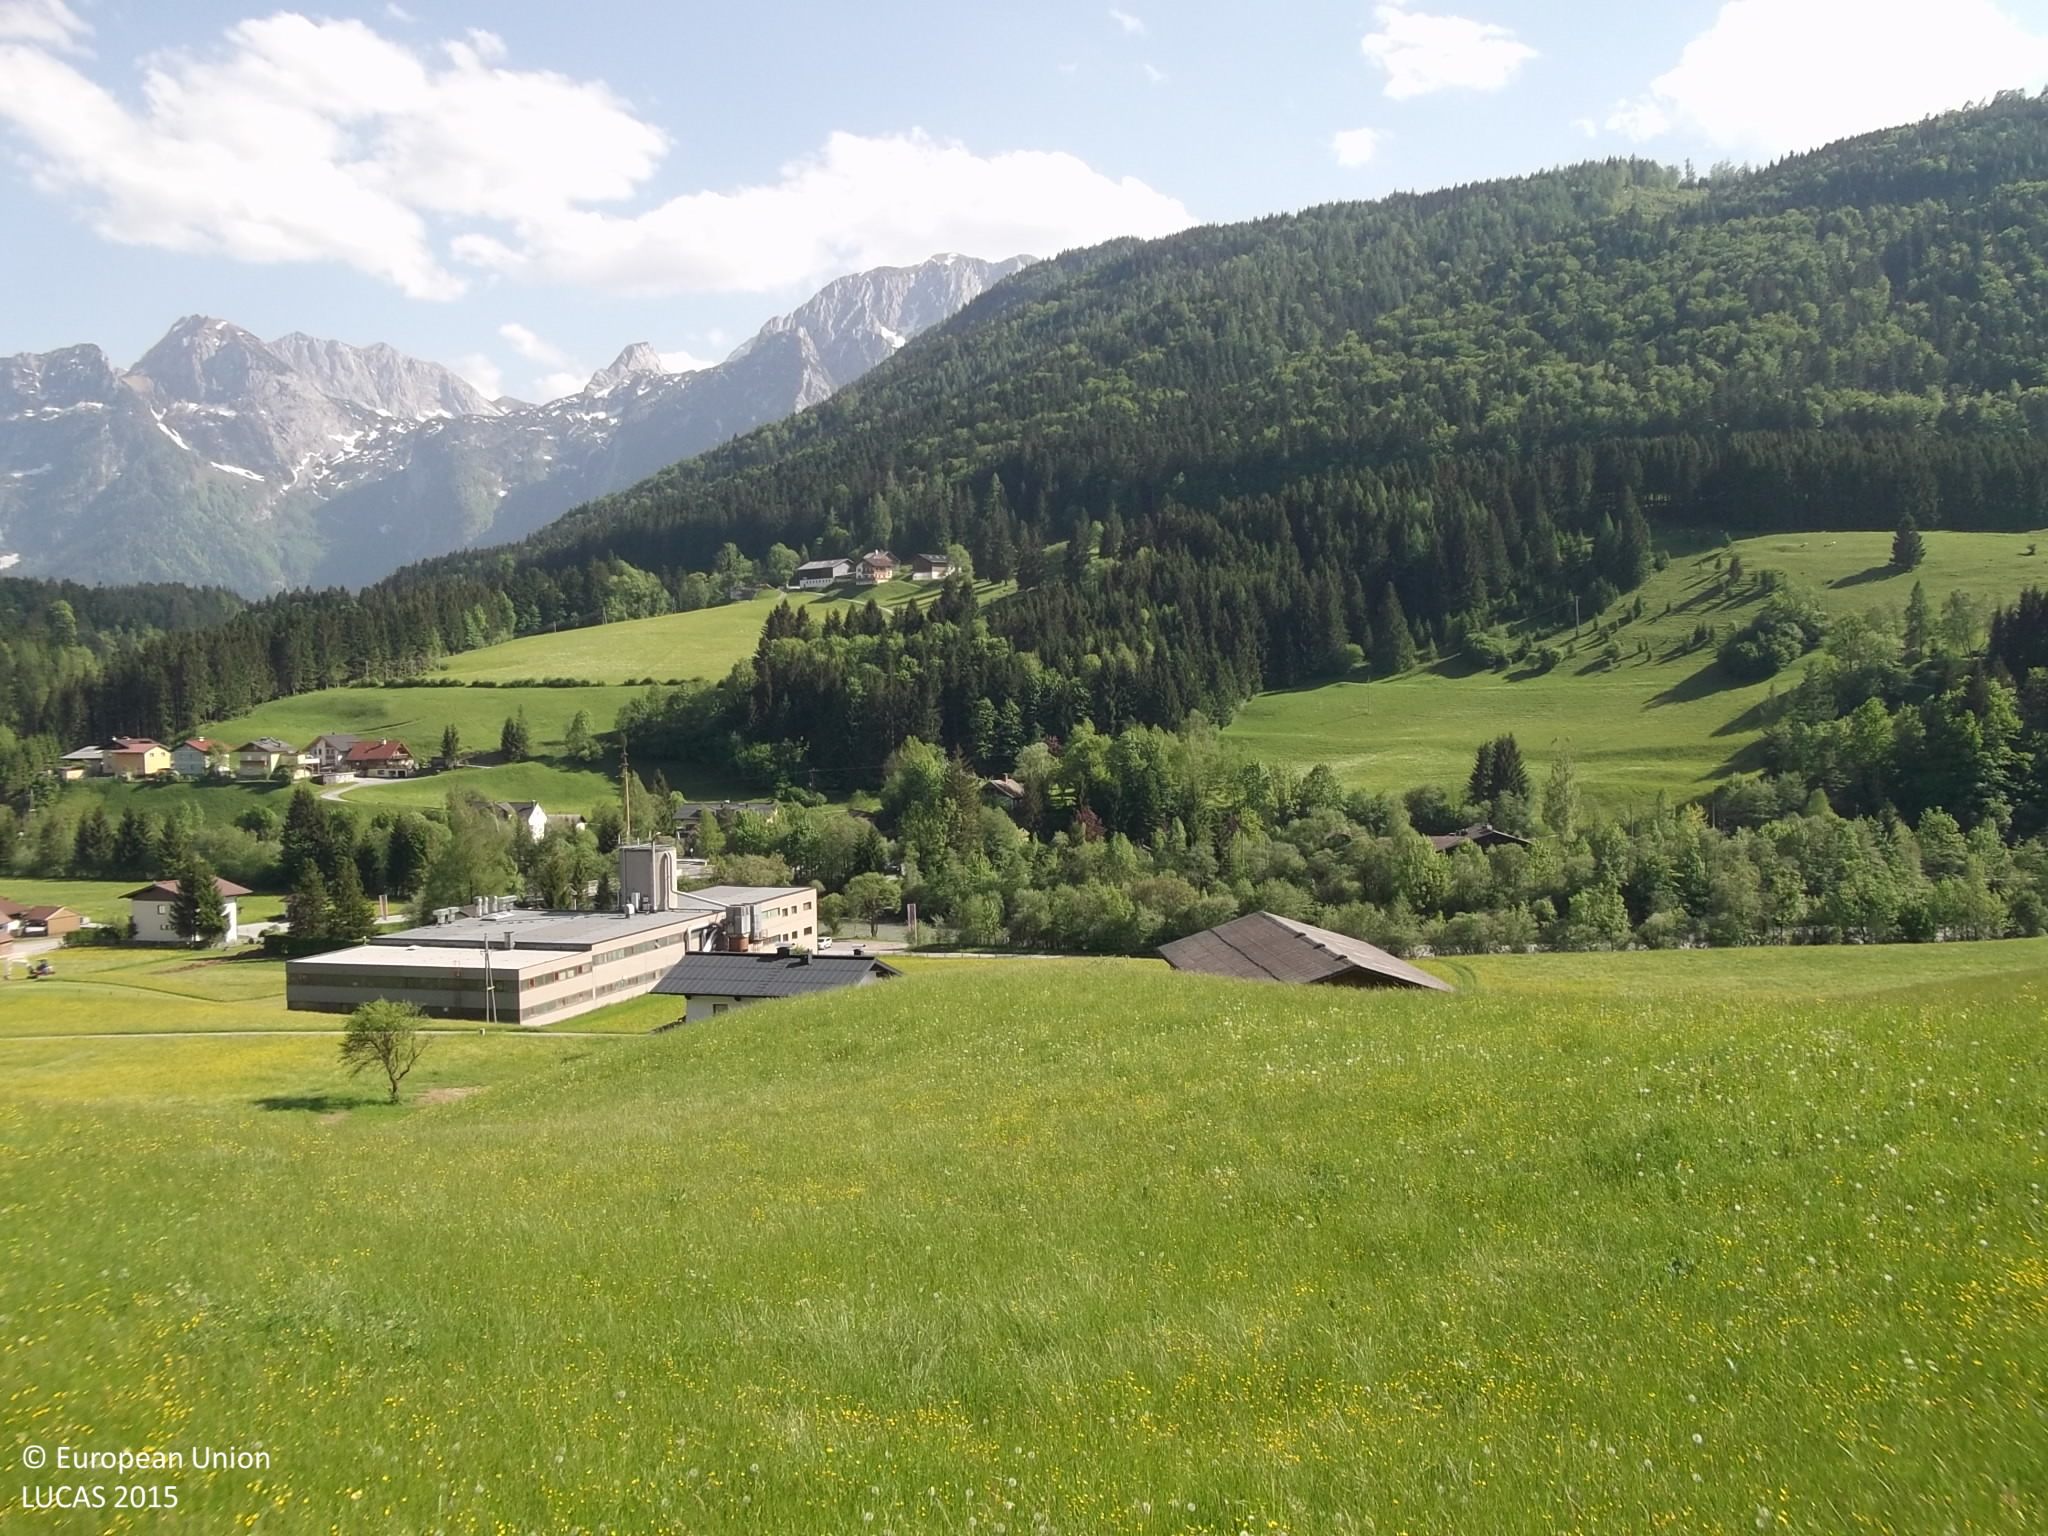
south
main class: Grassland
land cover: Grassland without tree/shrub cover
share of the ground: > 75 %
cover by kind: herbaceous plants 100 %
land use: Agriculture (excluding fallow land and kitchen gardens)
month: May
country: AT
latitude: 47.5975
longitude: 13.3101
